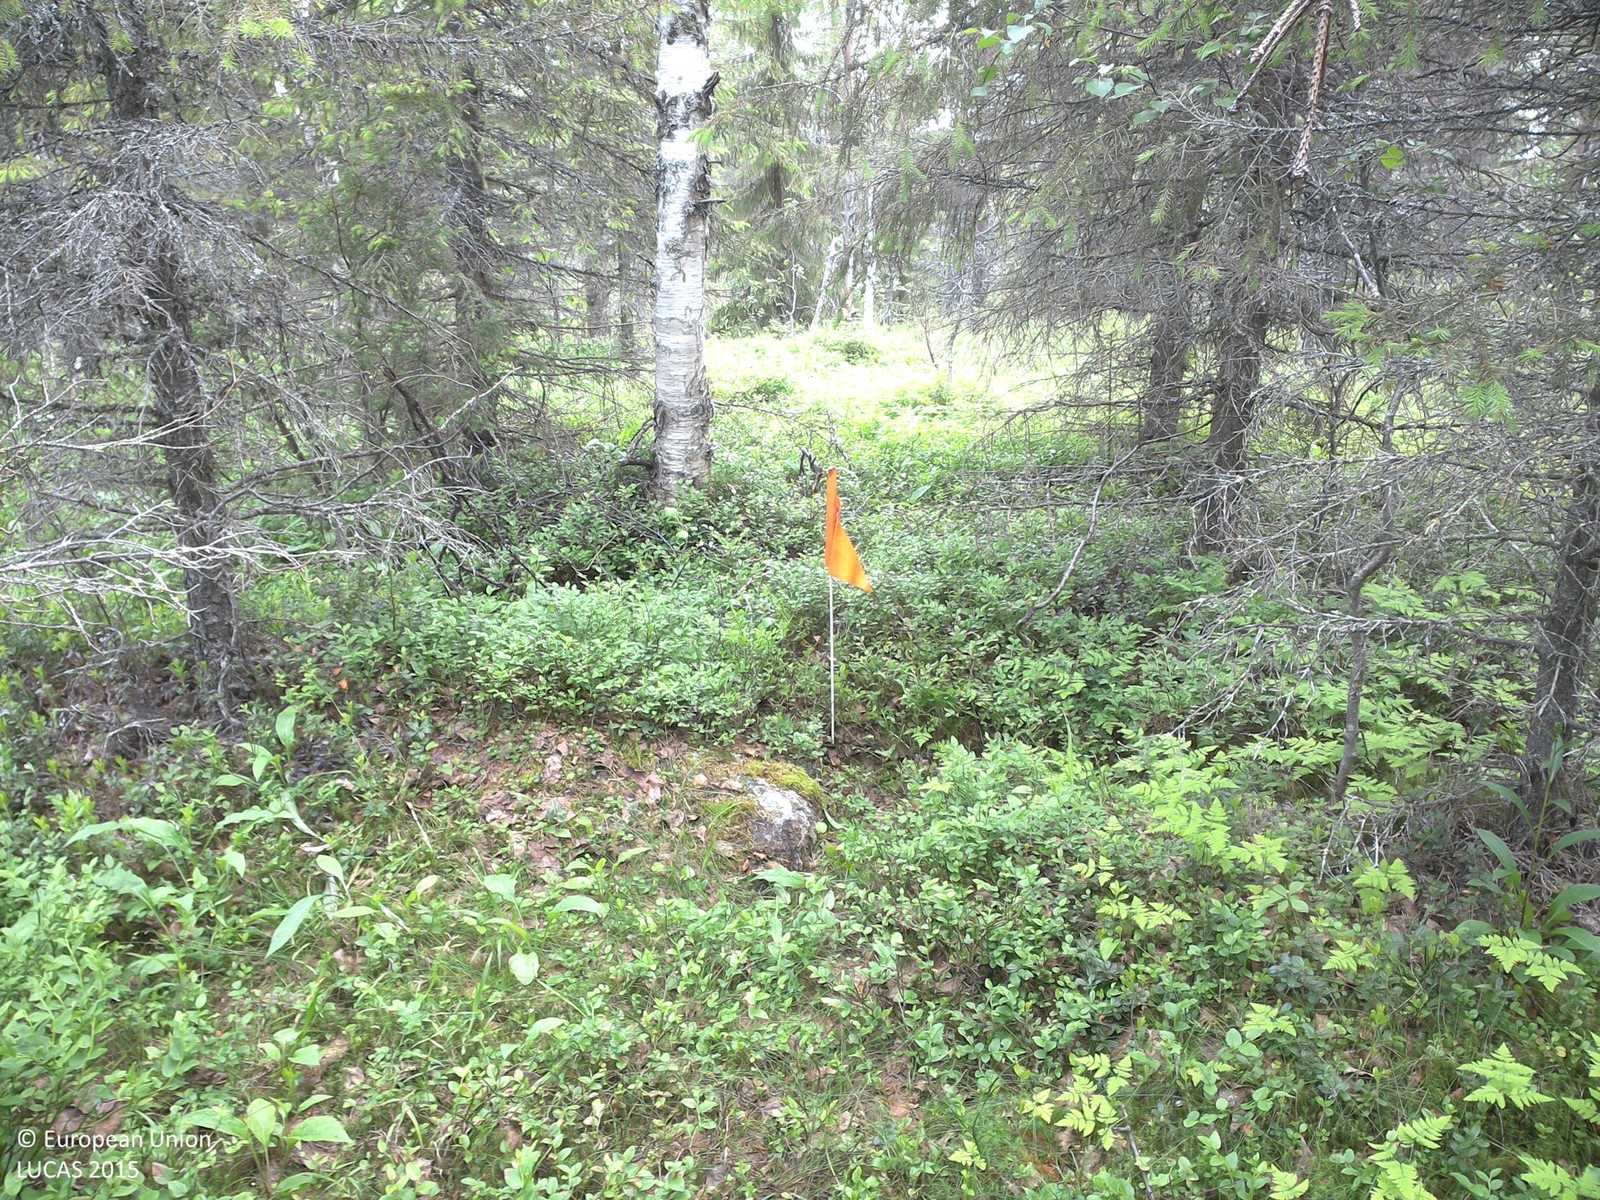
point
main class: Woodland
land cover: Spruce dominated mixed woodland
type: boreal forest
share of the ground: 25 - 50 %
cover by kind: shrubs 45 %, coniferous forest trees 30 %, herbaceous plants 15 %, broadleaved forest trees 10 %
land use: Forestry
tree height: > 5 m
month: July
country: SE
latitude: 66.7634
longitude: 23.4950
